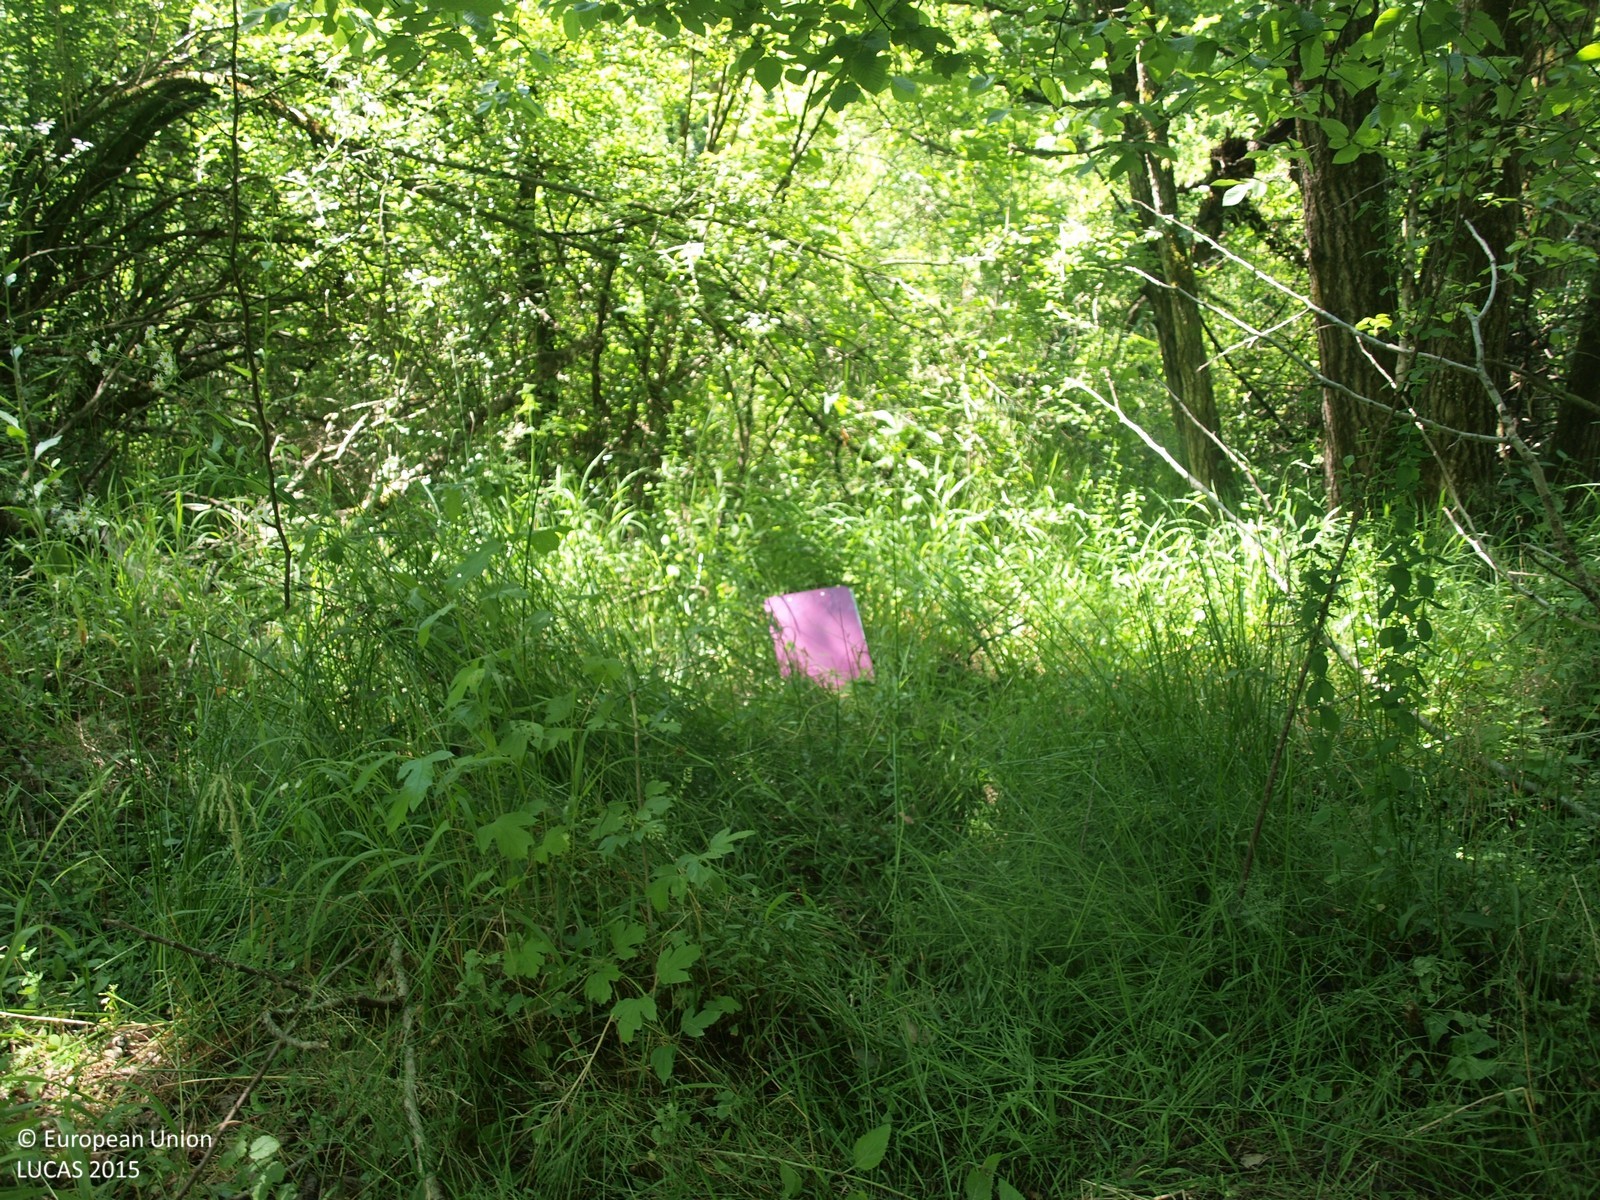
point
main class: Woodland
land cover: Broadleaved woodland
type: floodplain forest
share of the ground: > 75 %
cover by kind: broadleaved forest trees 100 %
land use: Forestry
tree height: > 5 m
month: July
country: HR
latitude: 45.6405
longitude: 15.6804
